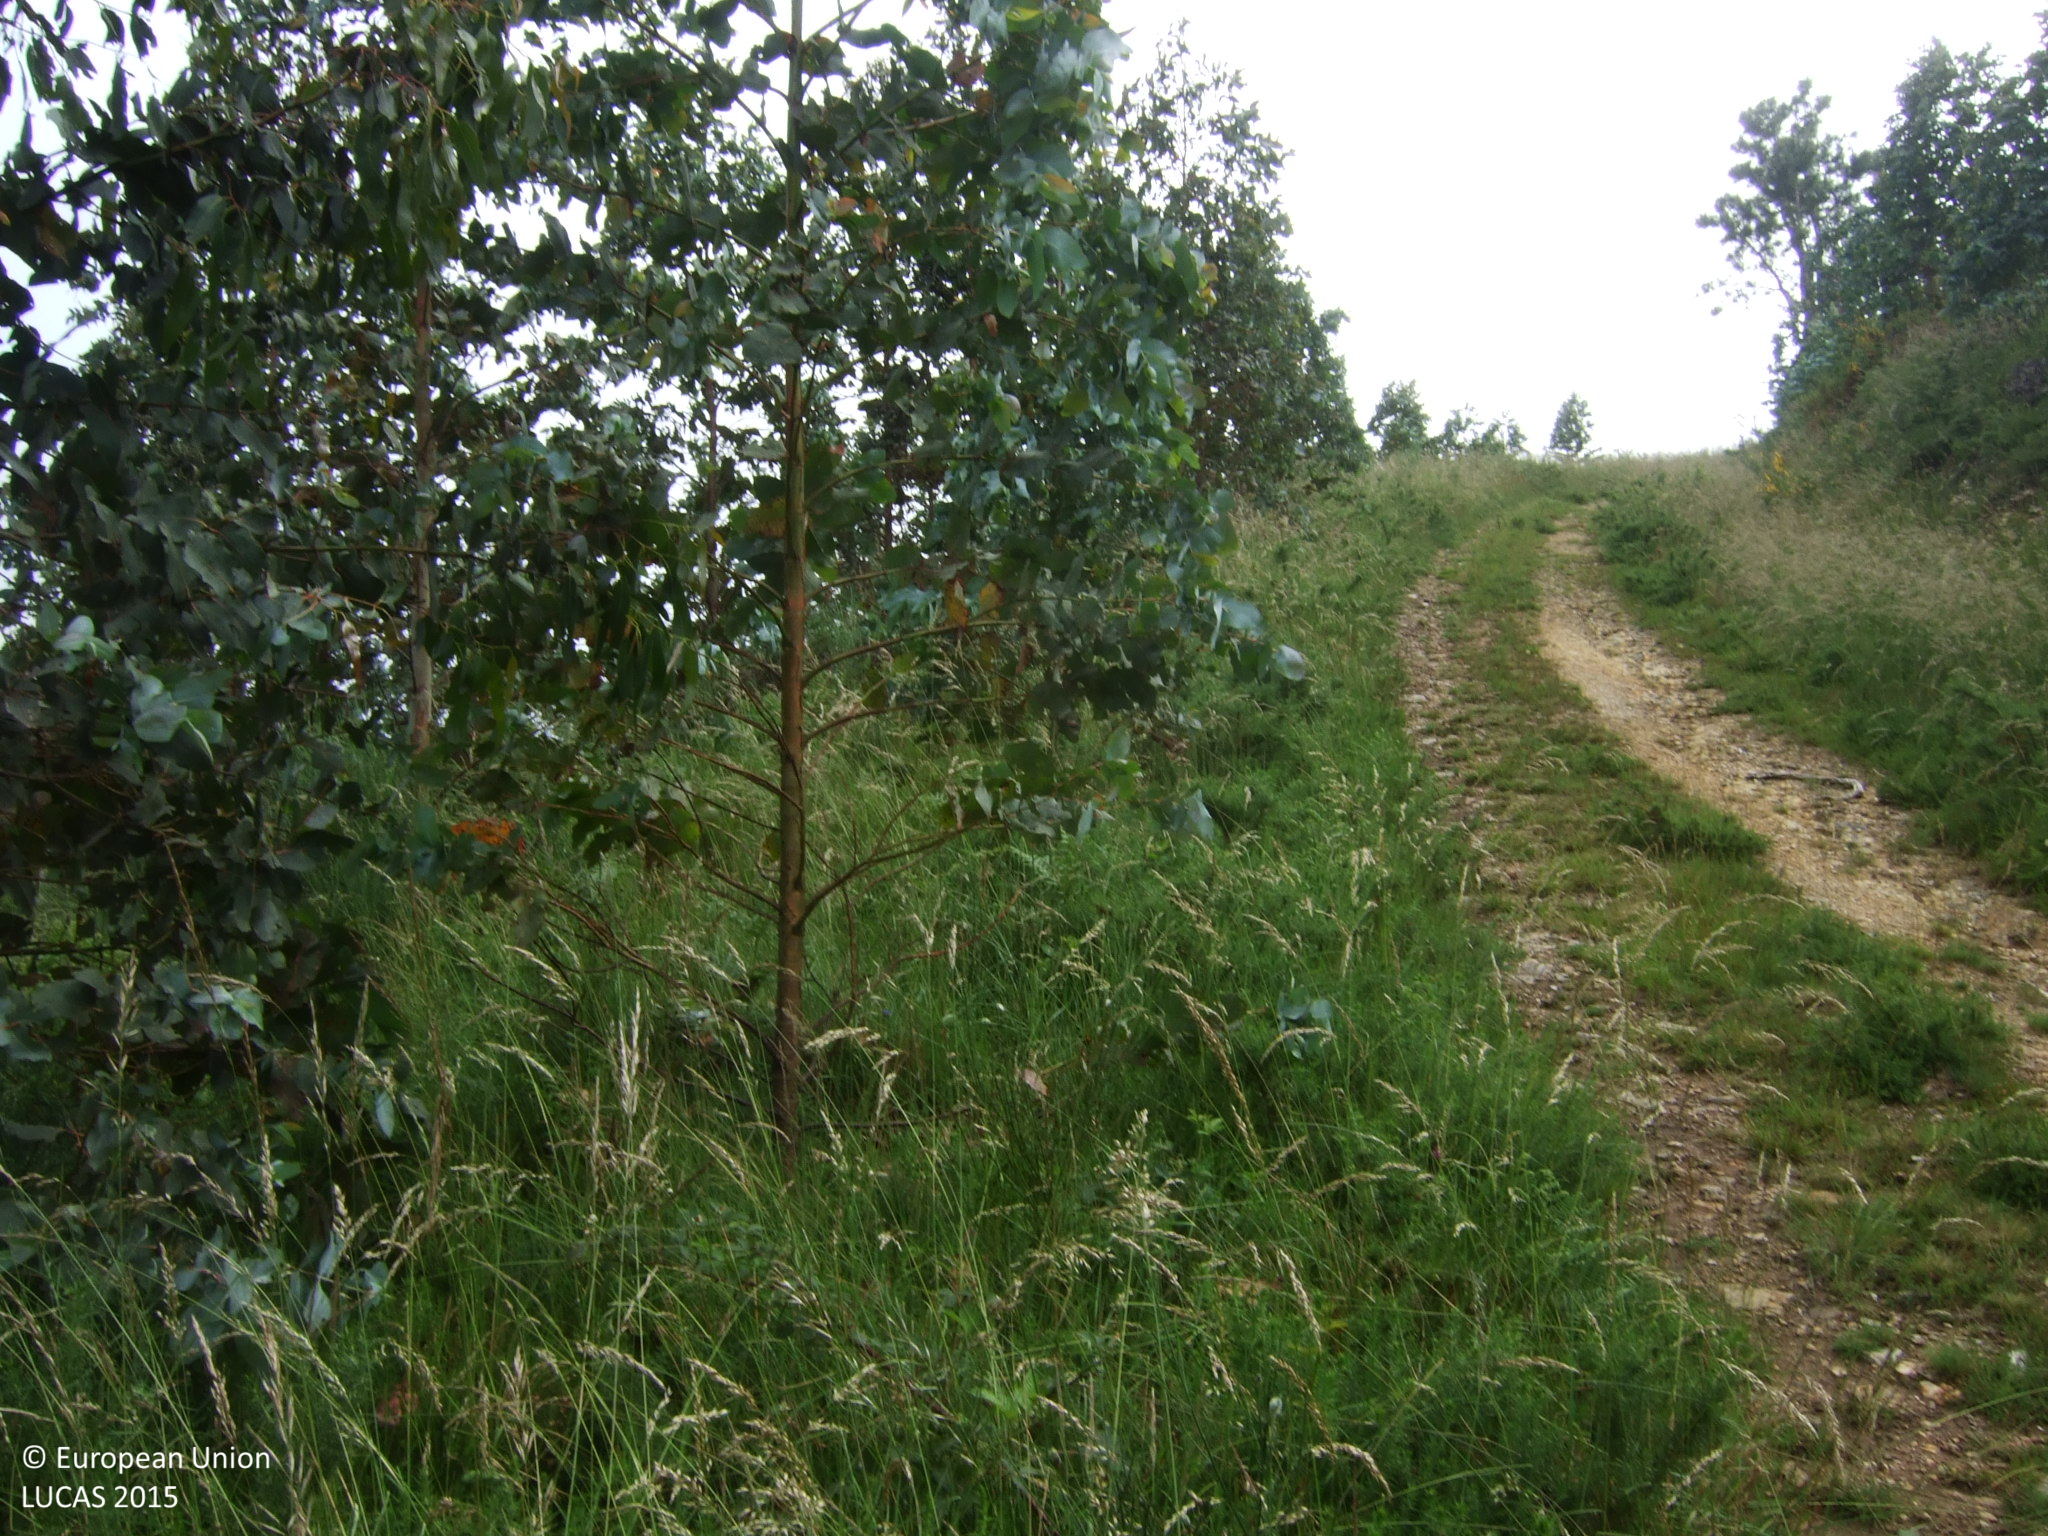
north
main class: Woodland
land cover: Broadleaved woodland
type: exotic forest
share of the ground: 25 - 50 %
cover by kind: shrubs 55 %, broadleaved forest trees 45 %
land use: Forestry
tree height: < 5 m
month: June
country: ES
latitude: 43.2813
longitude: -7.2378
